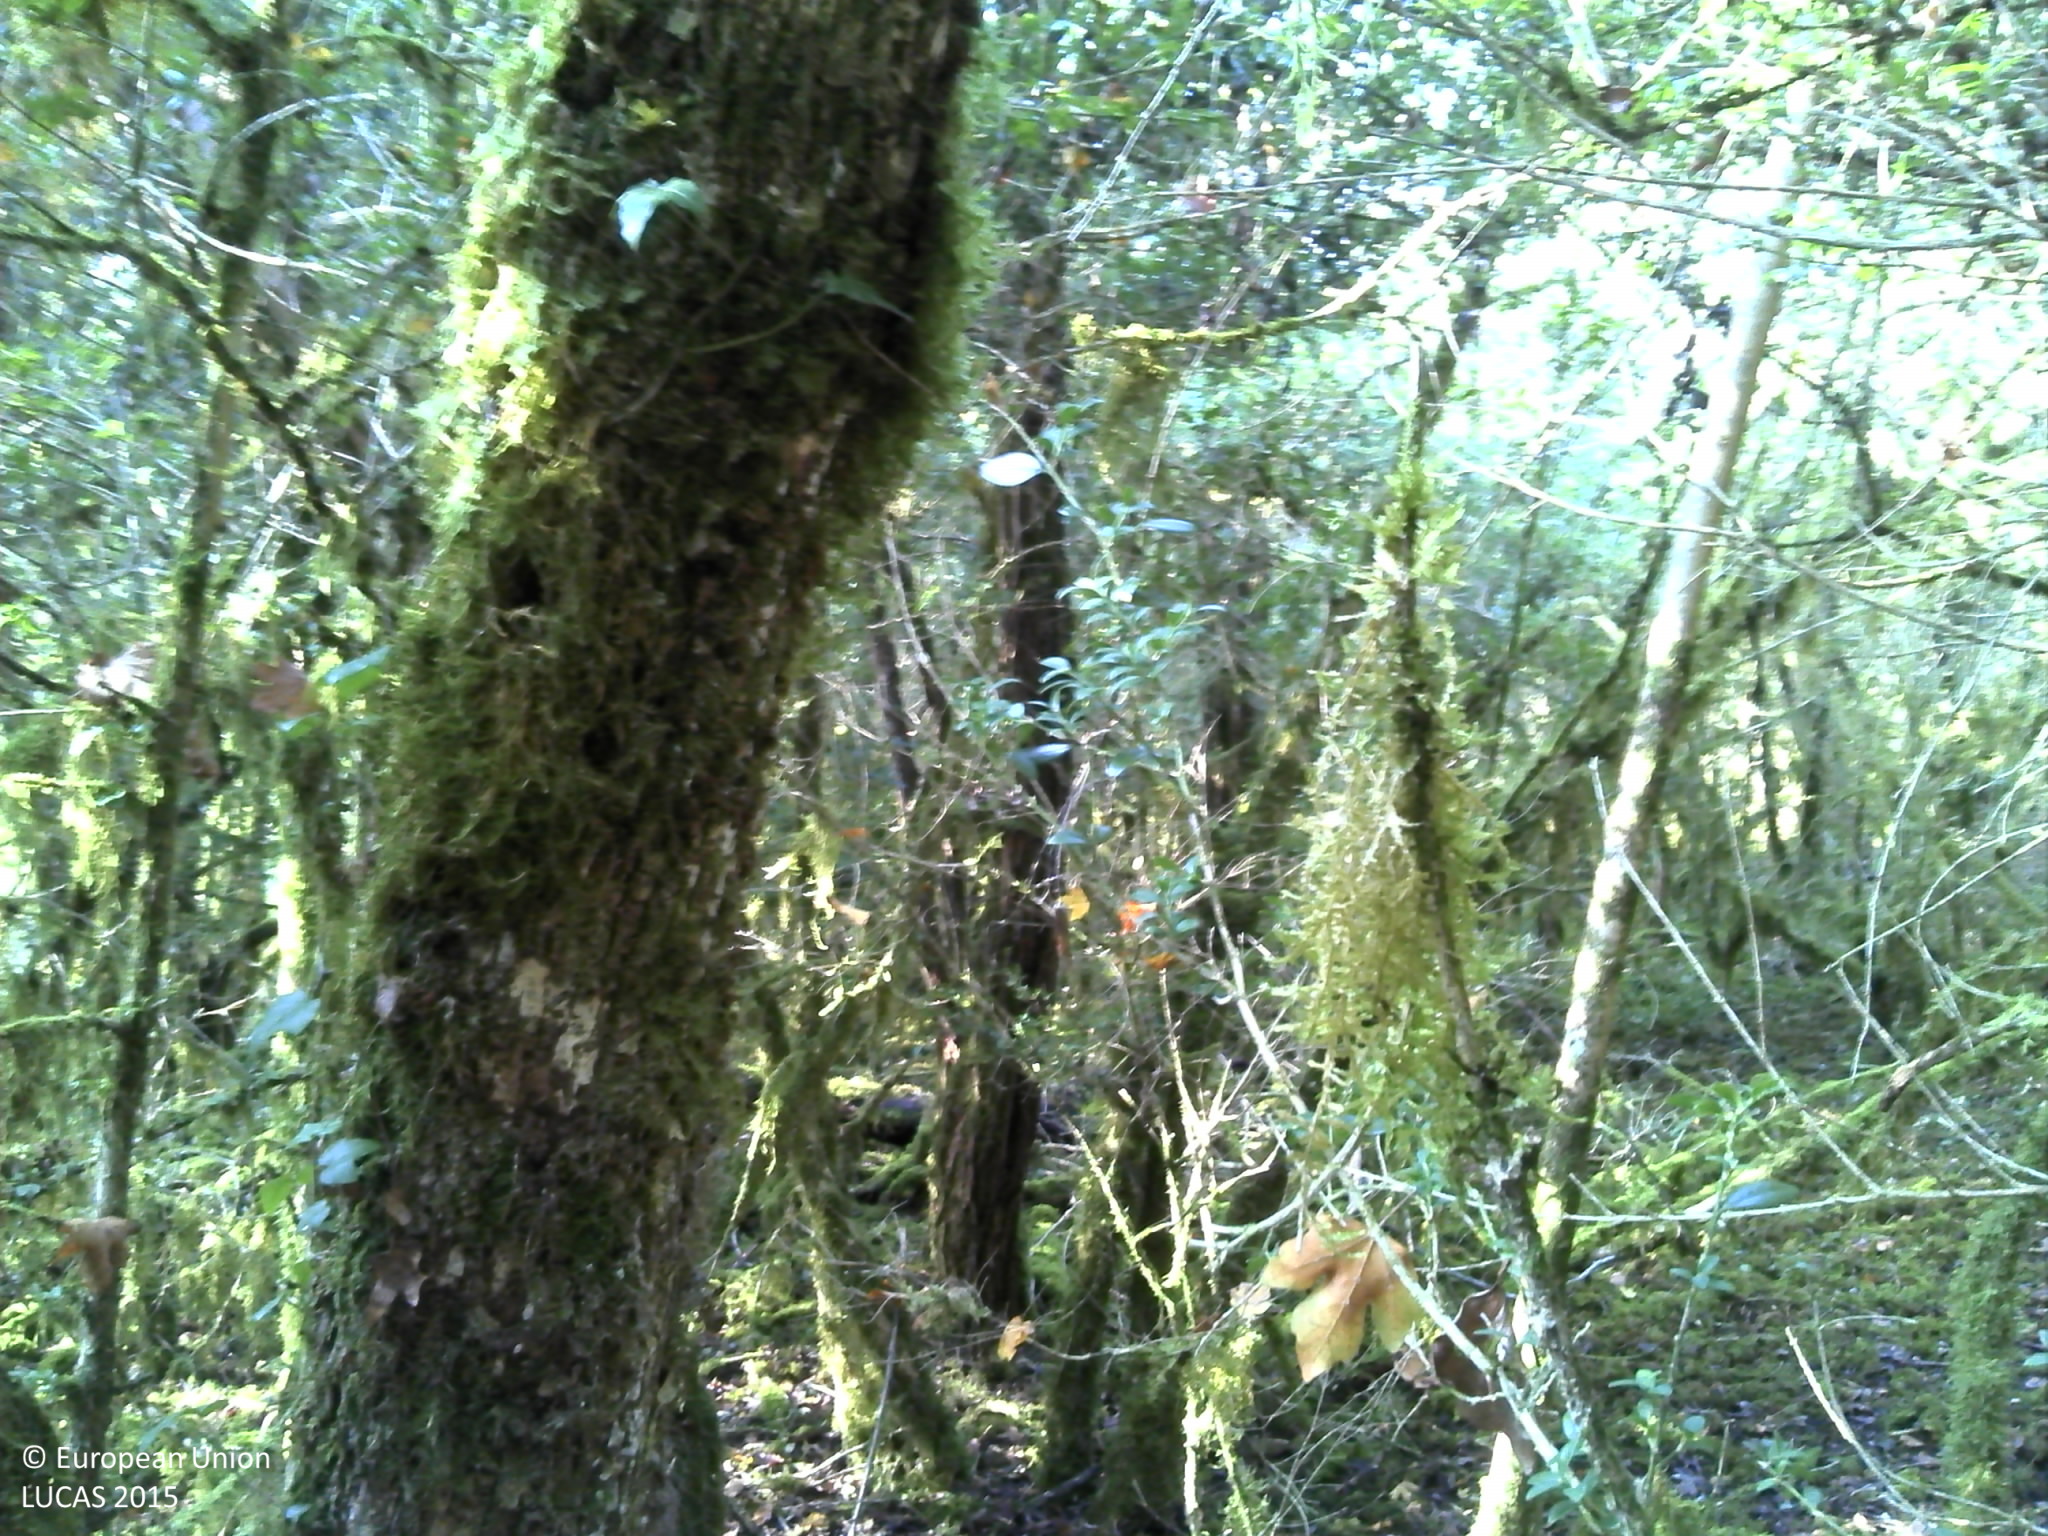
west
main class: Woodland
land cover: Broadleaved woodland
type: mesophytic deciduous forest
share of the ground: > 75 %
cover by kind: broadleaved forest trees 90 %, consolidated bare surface 5 %, unconsolidated bare surface 5 %
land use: Semi-natural and natural areas not in use
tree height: > 5 m
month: October
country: FR
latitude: 46.1623
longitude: 5.4058
